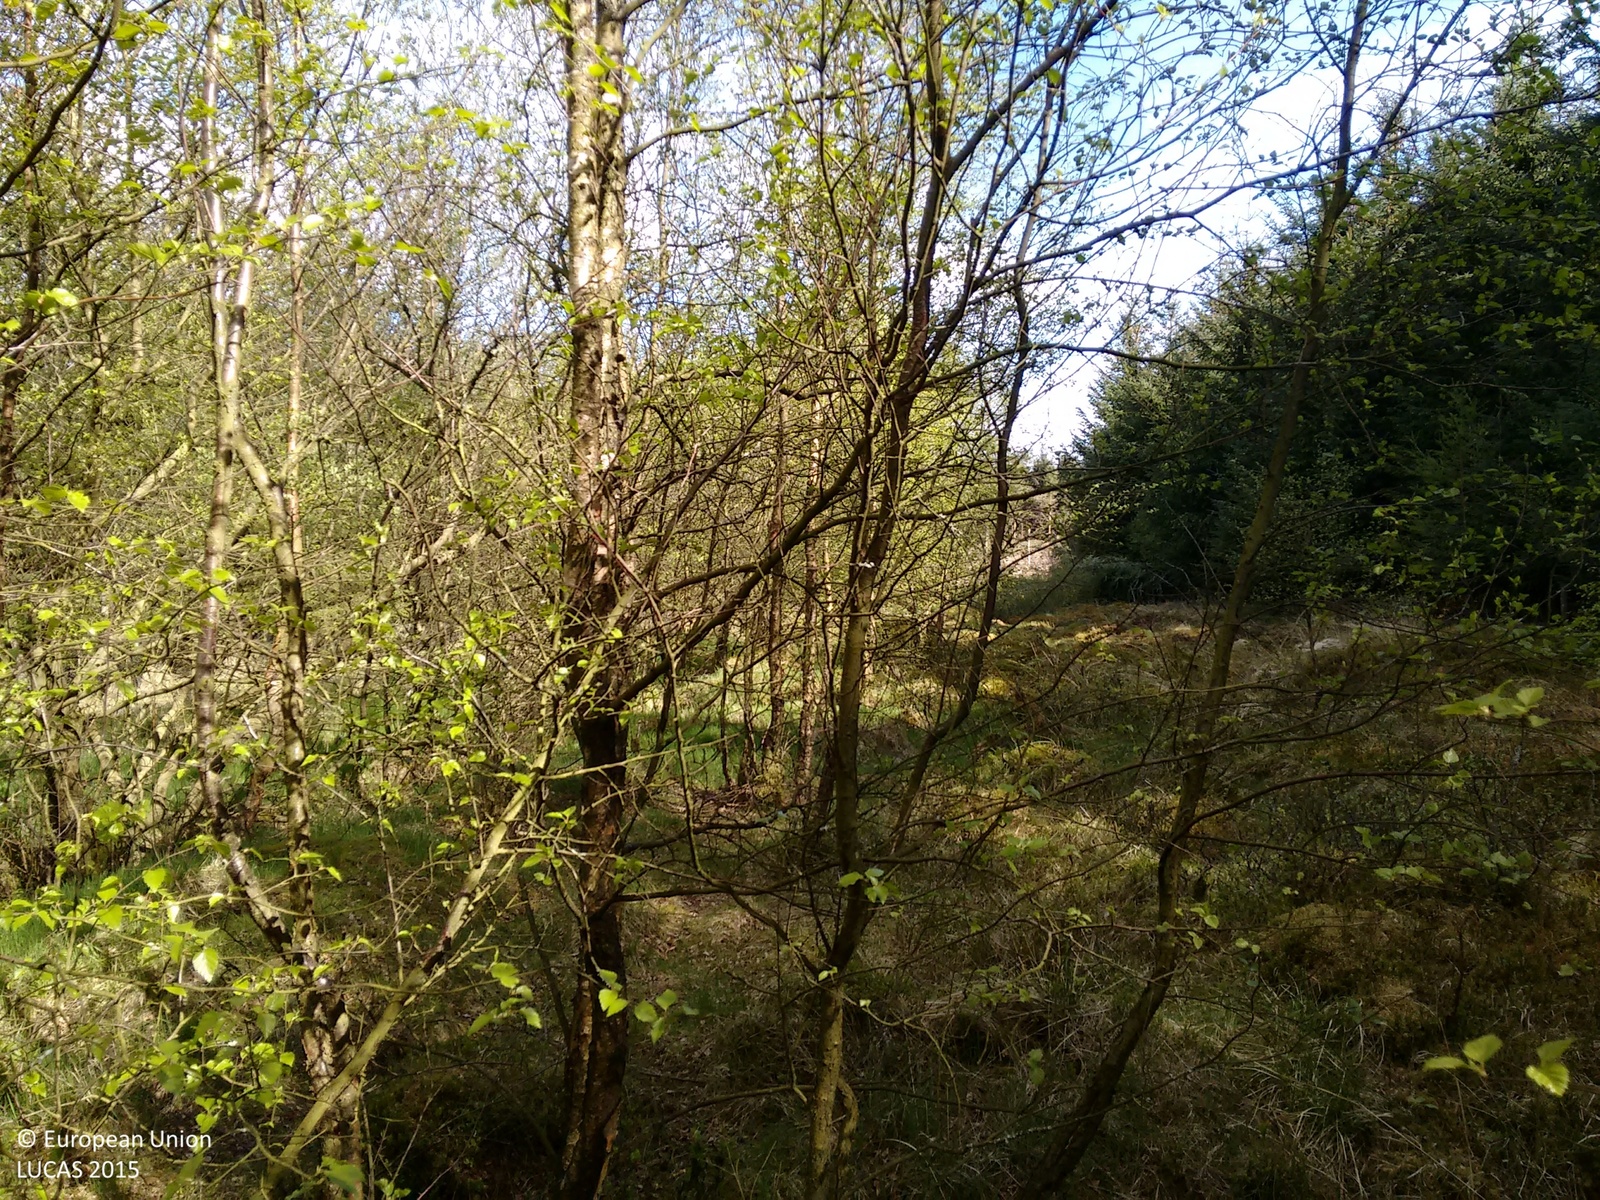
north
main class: Woodland
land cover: Broadleaved woodland
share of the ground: > 75 %
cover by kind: broadleaved forest trees 100 %
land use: Forestry
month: May
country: GB
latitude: 56.1908
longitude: -3.9272
